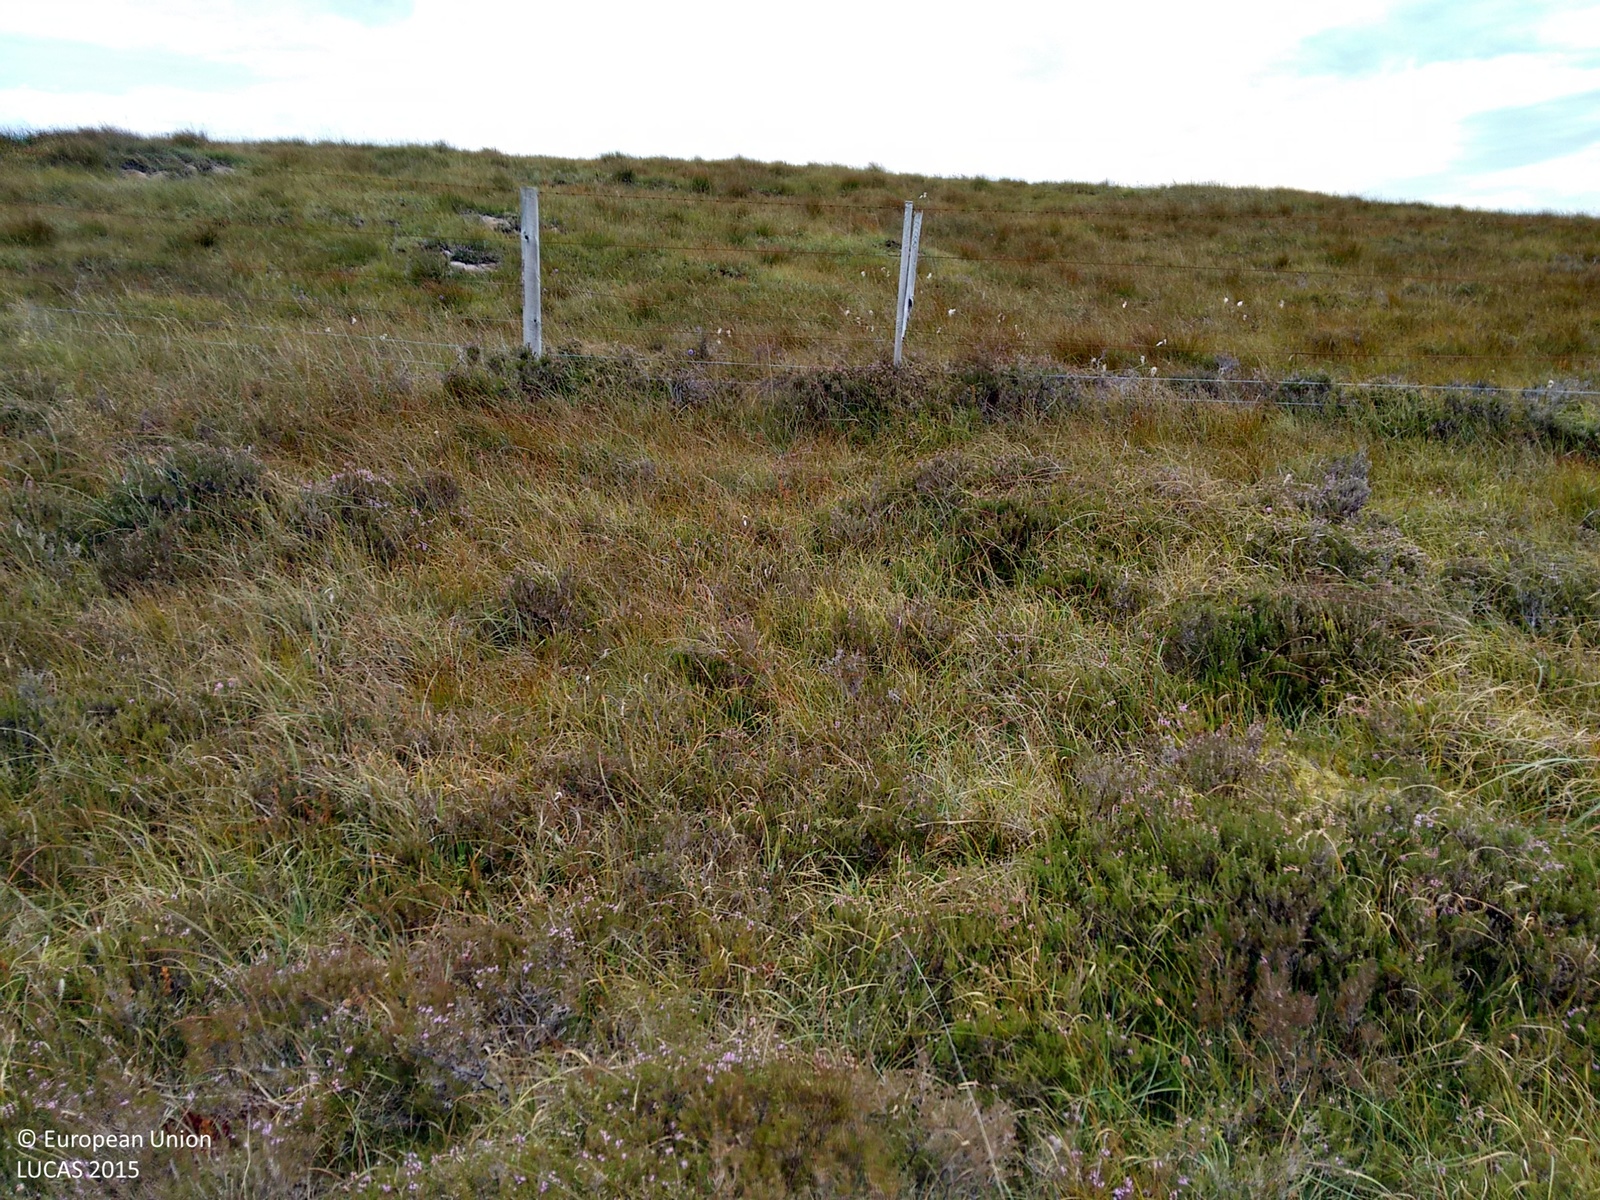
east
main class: Shrubland
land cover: Shrubland without tree cover
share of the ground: > 75 %
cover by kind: shrubs 80 %, herbaceous plants 20 %
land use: Agriculture (excluding fallow land and kitchen gardens)
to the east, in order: Shrubland without tree cover; Fences; Shrubland without tree cover; Ponds and wetlands; Shrubland without tree cover; Rock outcrops; Shrubland without tree cover; Rivers and streams; Shrubland without tree cover
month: September
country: GB
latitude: 57.4549
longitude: -6.2867
